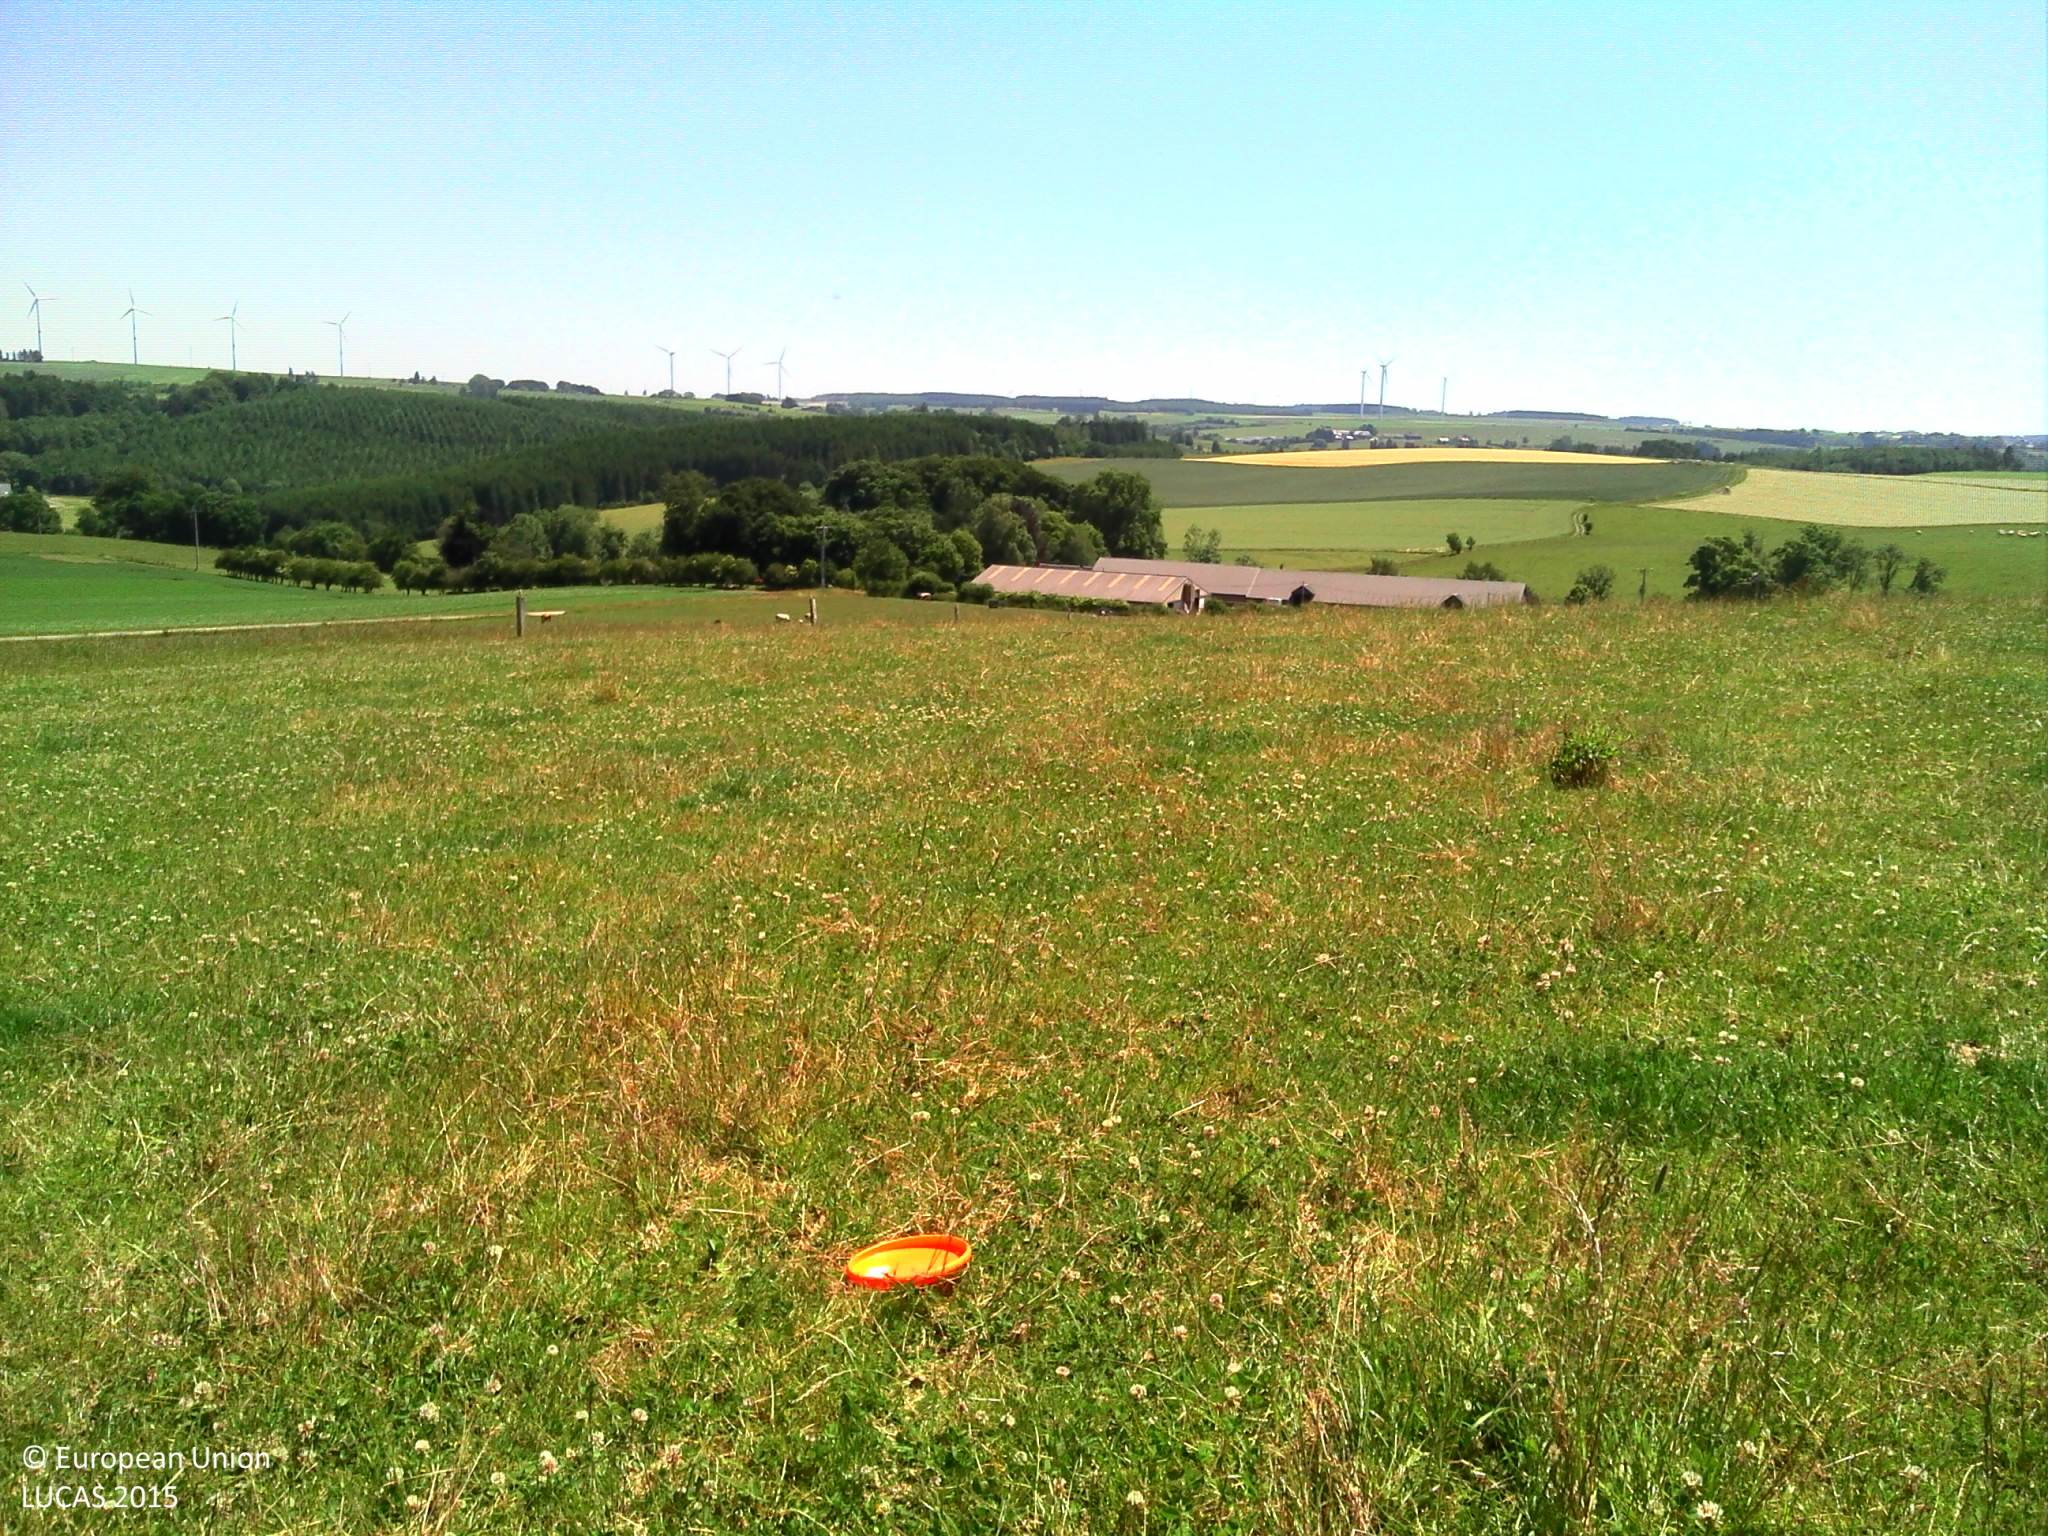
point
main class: Grassland
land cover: Grassland without tree/shrub cover
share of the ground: > 75 %
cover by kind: herbaceous plants 100 %
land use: Agriculture (excluding fallow land and kitchen gardens)
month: June
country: BE
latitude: 50.0252
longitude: 5.5457
